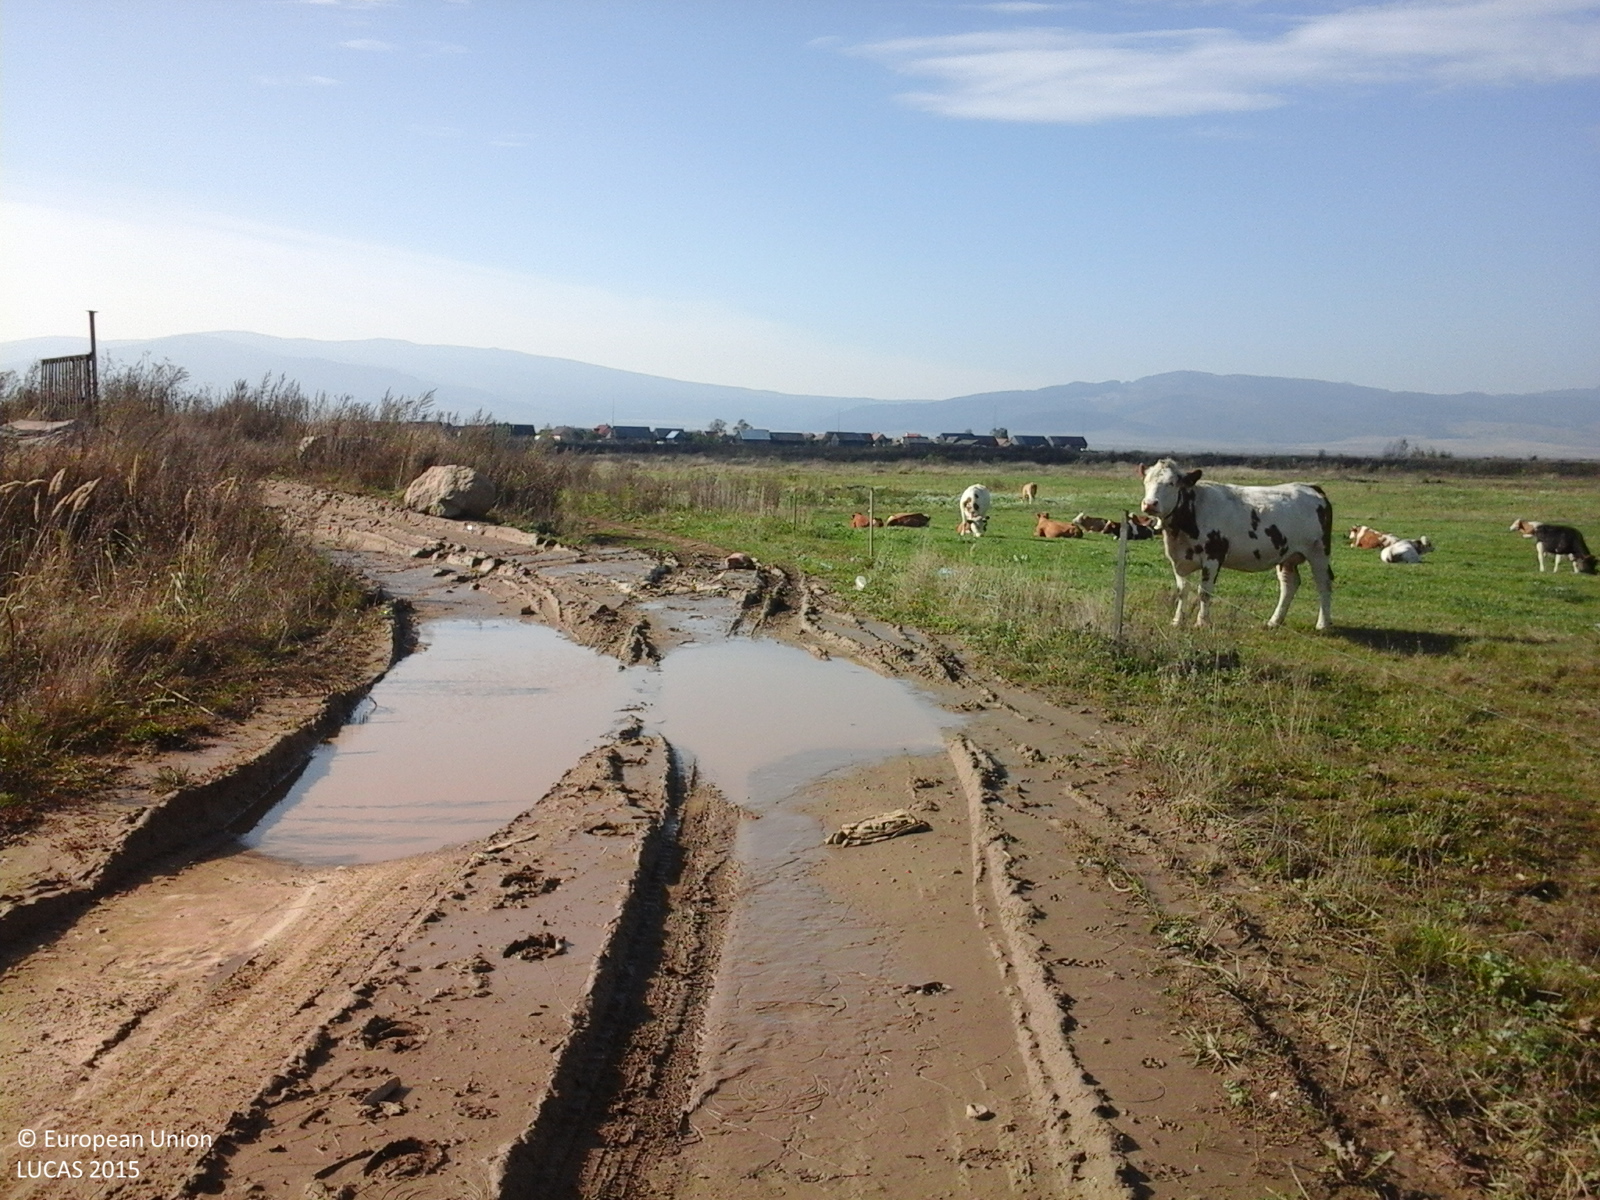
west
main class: Grassland
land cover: Grassland without tree/shrub cover
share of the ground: > 75 %
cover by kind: herbaceous plants 100 %
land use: Agriculture (excluding fallow land and kitchen gardens)
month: October
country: RO
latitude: 46.7143
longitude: 25.5078
